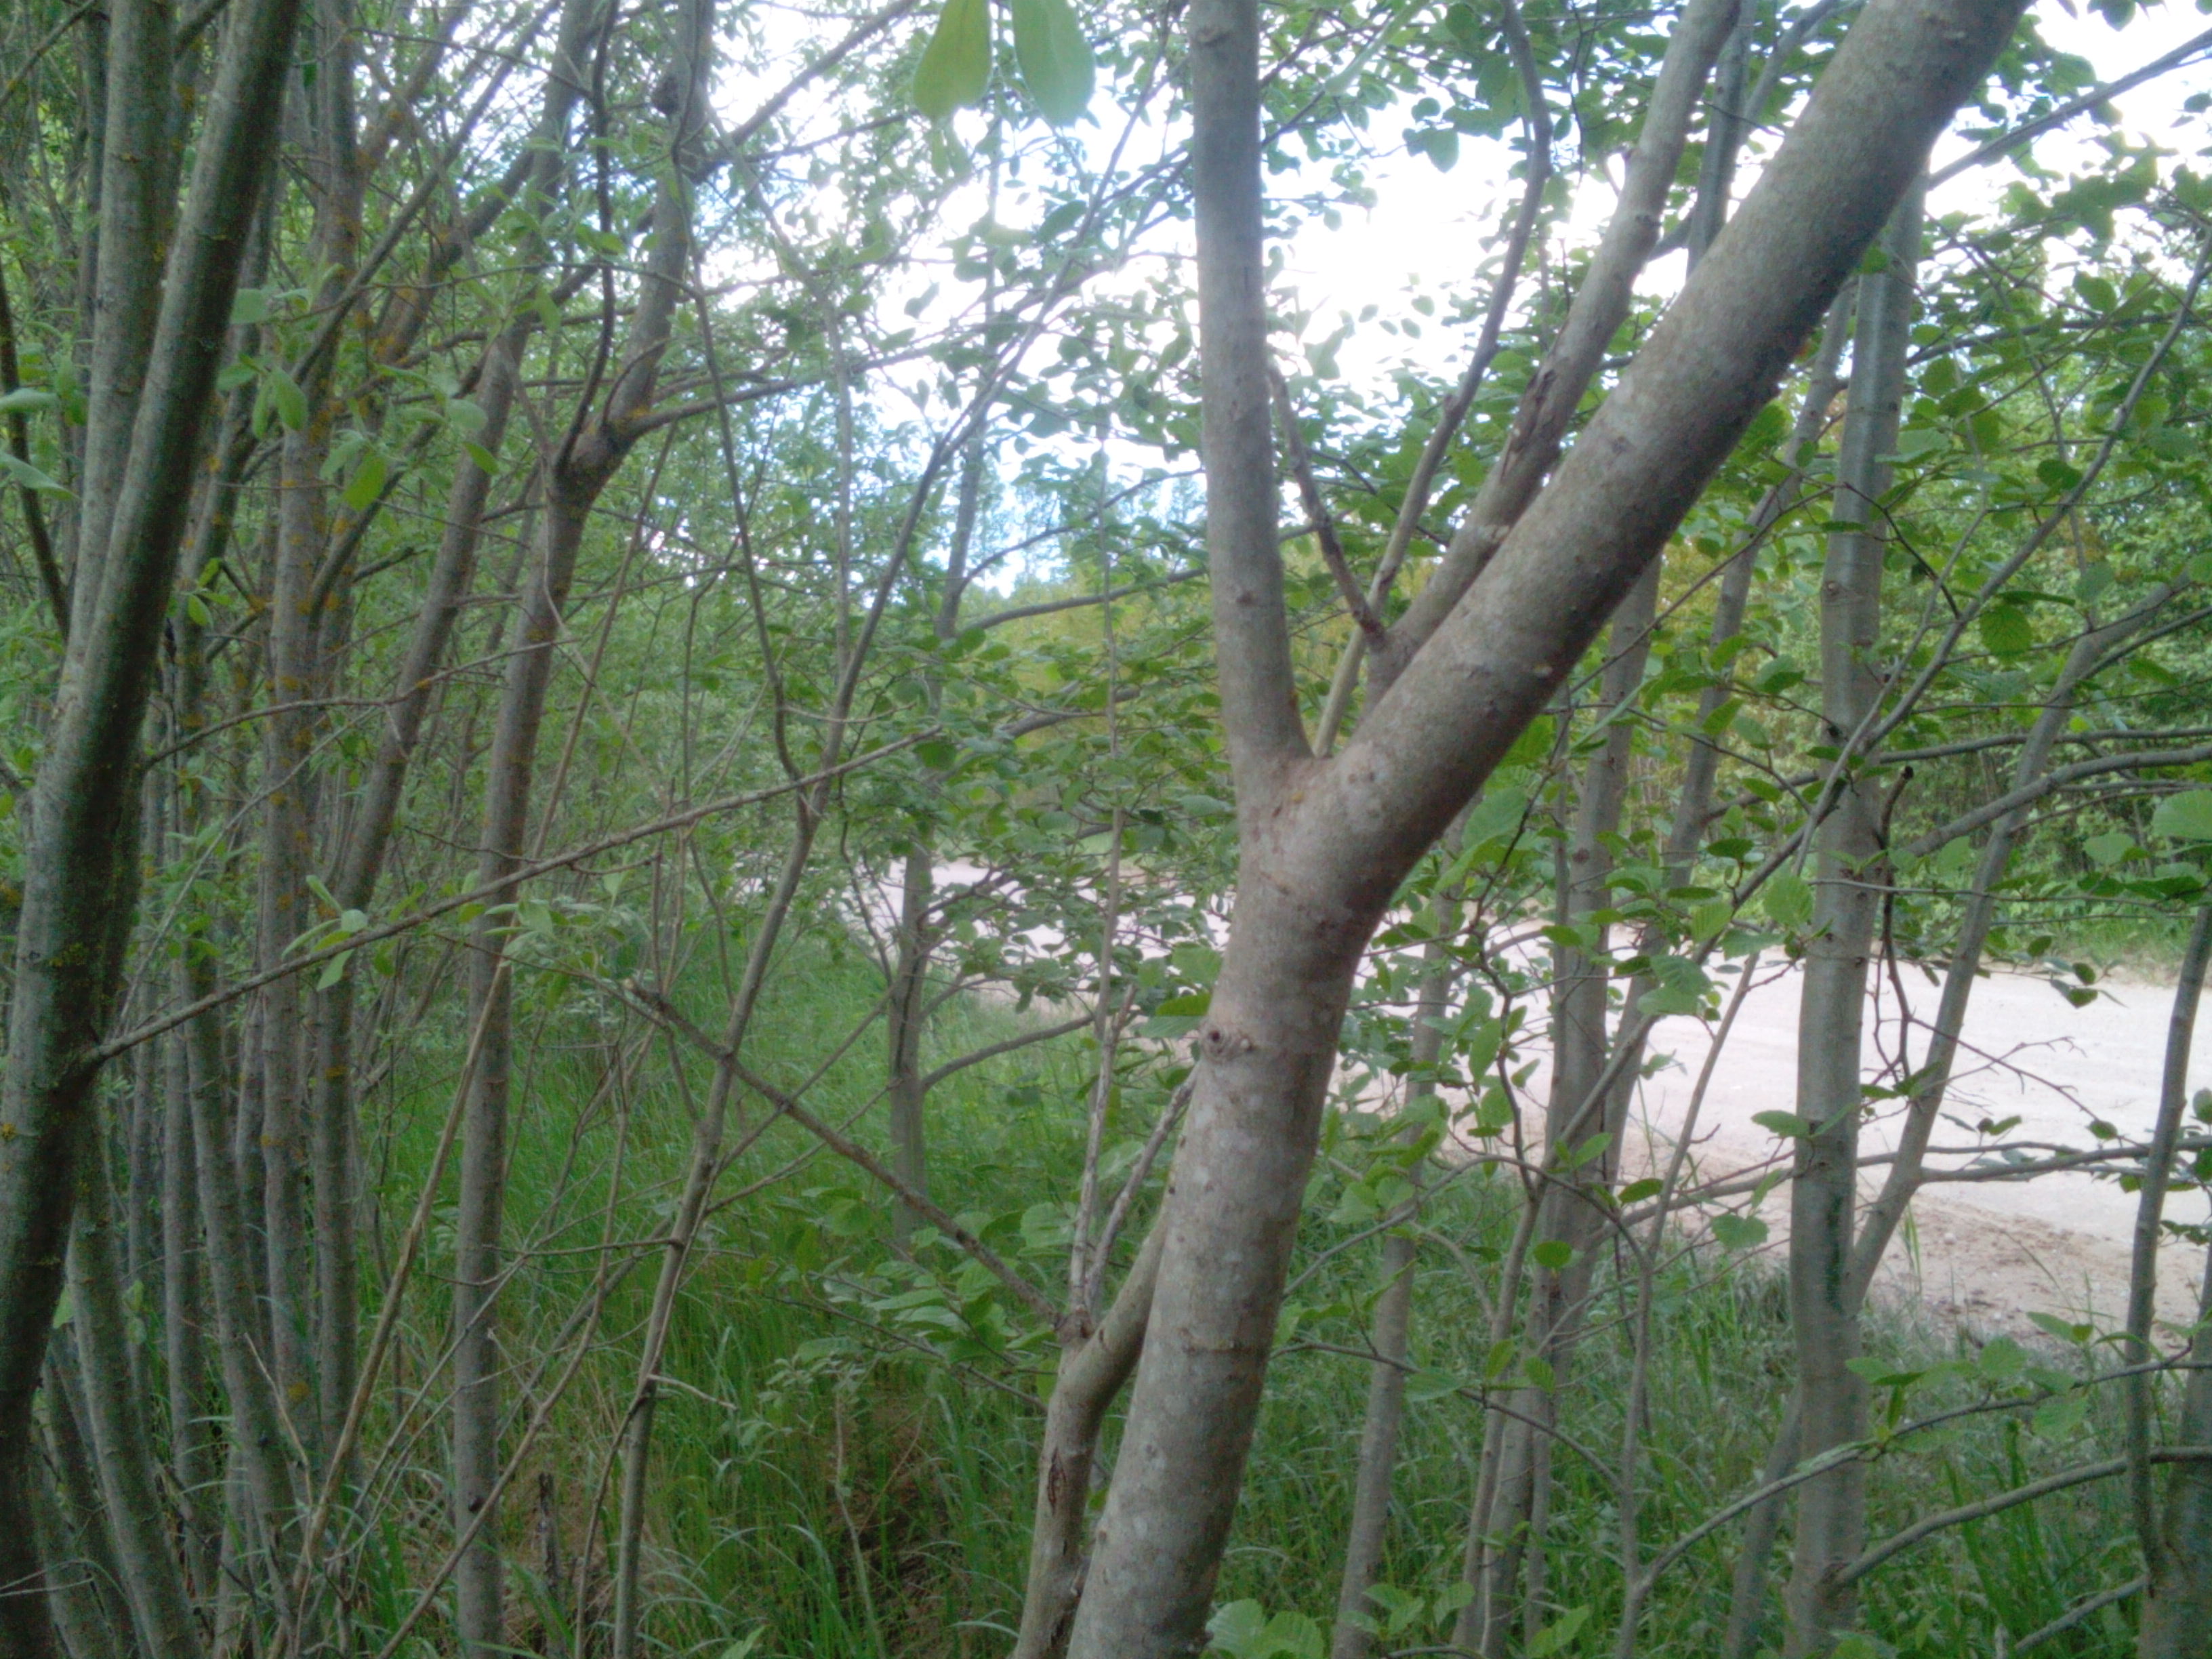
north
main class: Shrubland
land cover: Shrubland without tree cover
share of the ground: > 75 %
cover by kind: shrubs 80 %, herbaceous plants 20 %
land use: Forestry
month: May
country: LV
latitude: 56.5196
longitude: 22.3259
